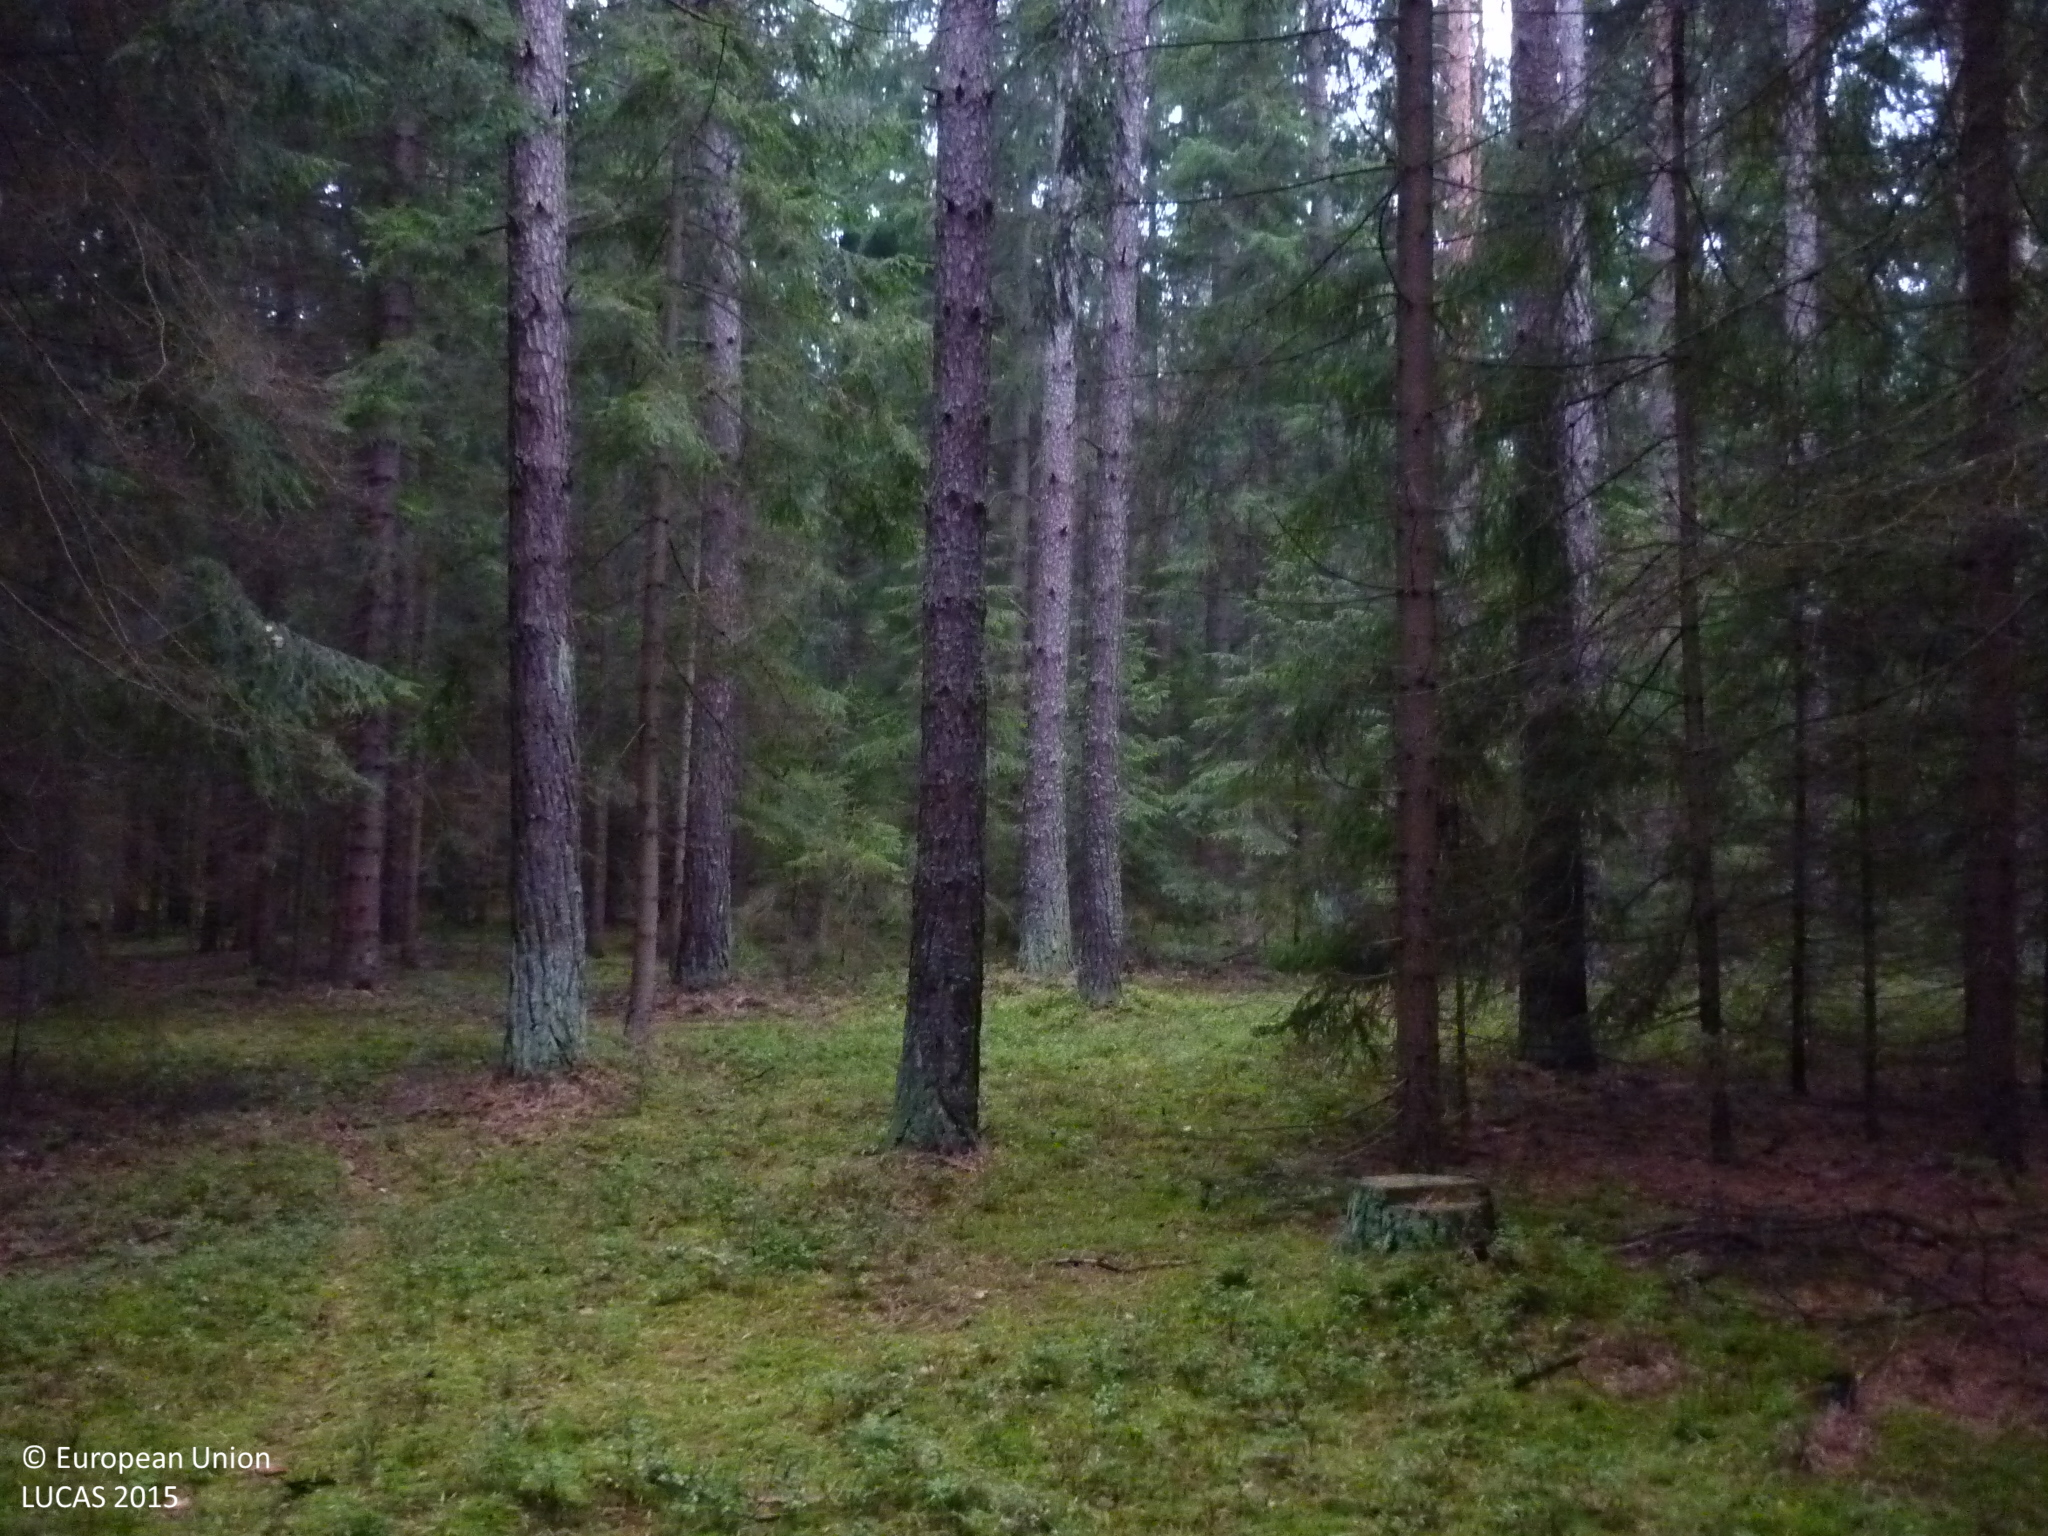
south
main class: Woodland
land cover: Spruce dominated coniferous woodland
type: hemiboreal forest and nemoral coniferous forest and mixed broadleaved-coniferous forest
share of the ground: > 75 %
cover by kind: coniferous forest trees 90 %, lichens and mosses 10 %
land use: Forestry
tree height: > 5 m
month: September
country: AT
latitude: 48.9184
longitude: 15.0650
